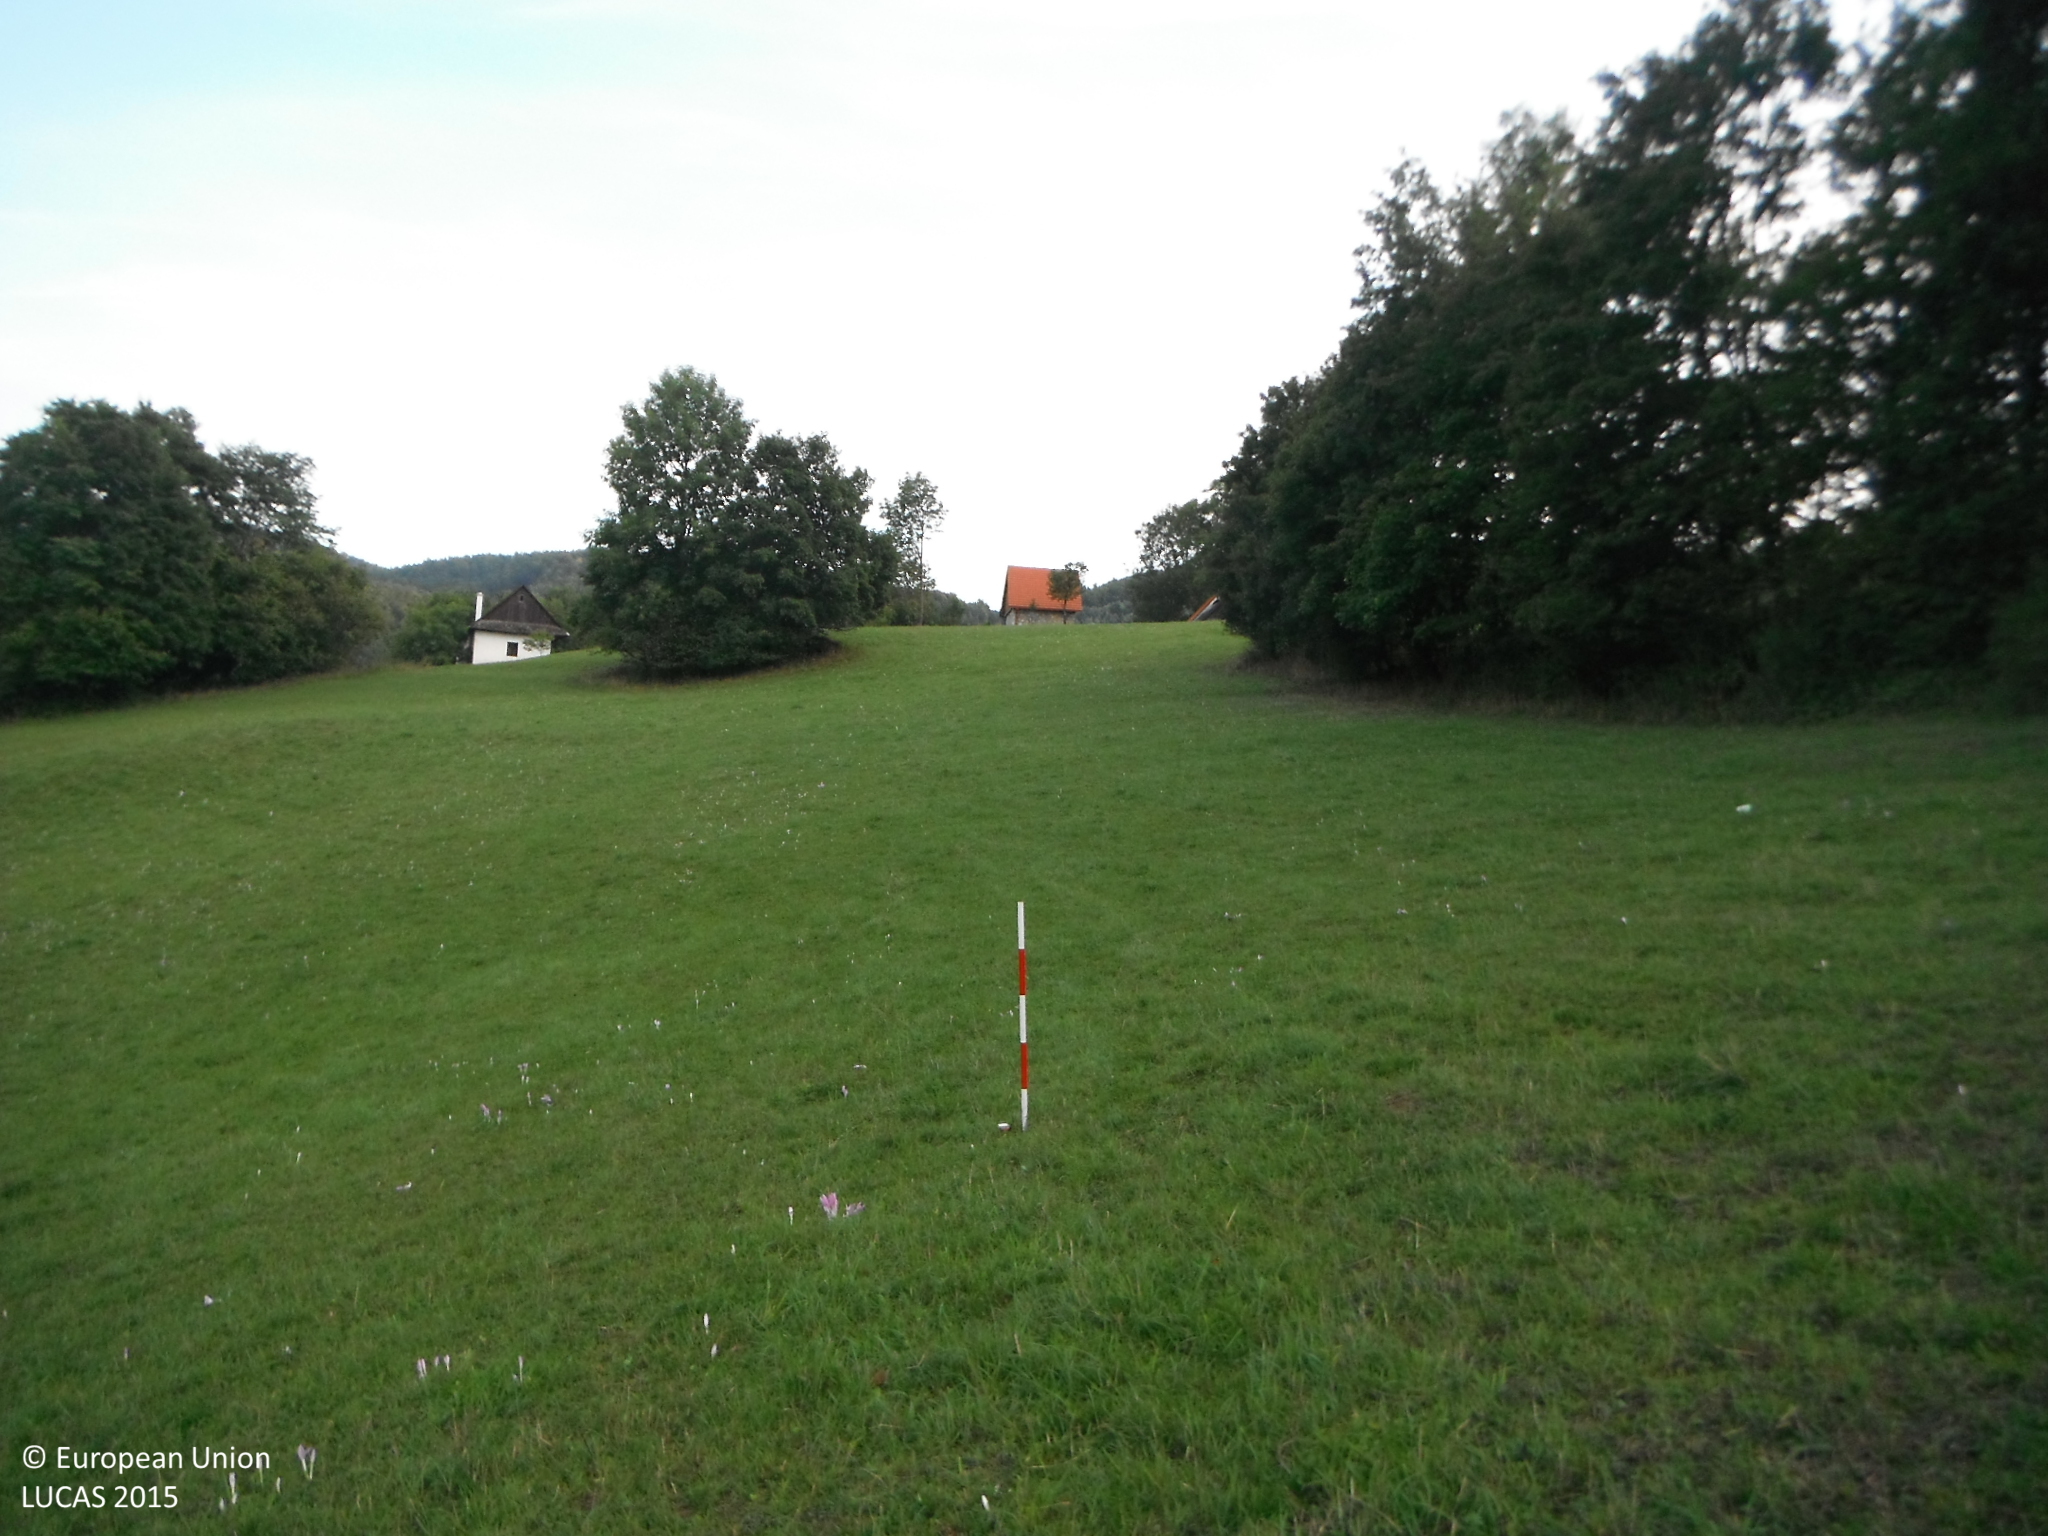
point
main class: Grassland
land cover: Grassland without tree/shrub cover
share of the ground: > 75 %
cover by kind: herbaceous plants 100 %
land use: Agriculture (excluding fallow land and kitchen gardens)
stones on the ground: < 10 %
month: September
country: SK
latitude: 48.8811
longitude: 18.3758
